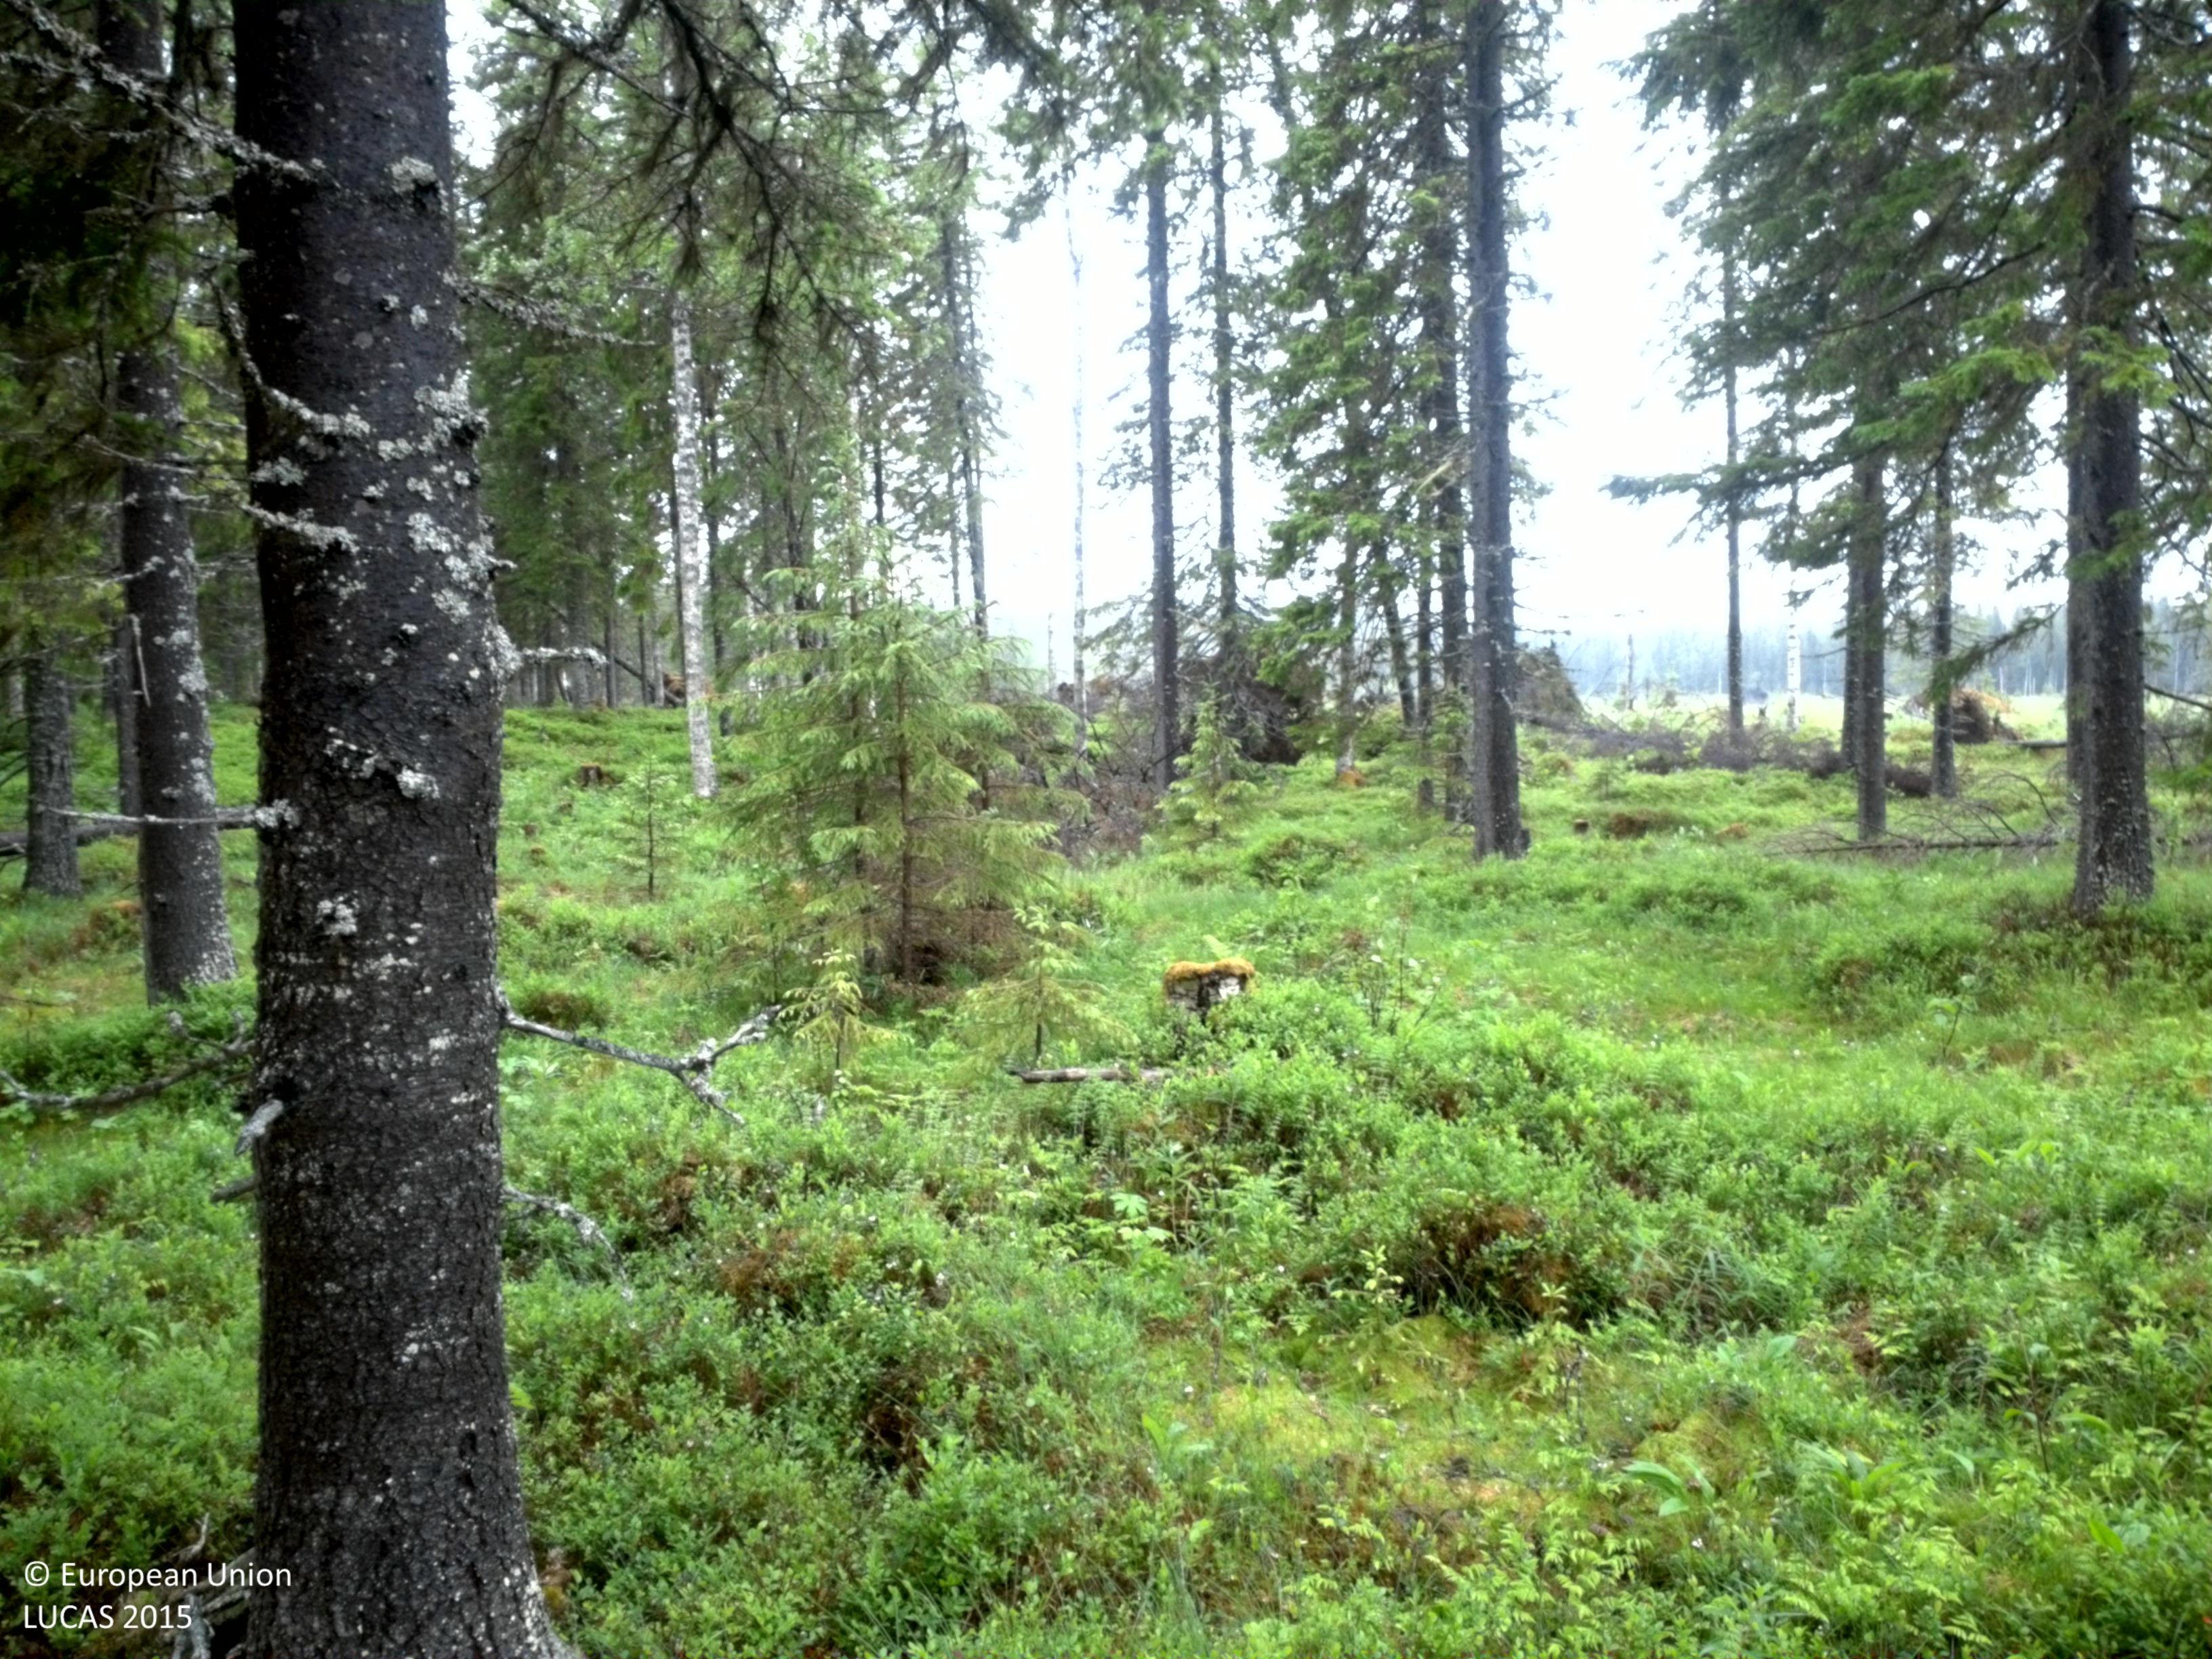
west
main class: Woodland
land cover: Spruce dominated mixed woodland
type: boreal forest
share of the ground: 50 - 75 %
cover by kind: coniferous forest trees 45 %, shrubs 35 %, broadleaved forest trees 15 %, herbaceous plants 5 %
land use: Forestry
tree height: > 5 m
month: July
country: SE
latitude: 64.5733
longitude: 18.0872
